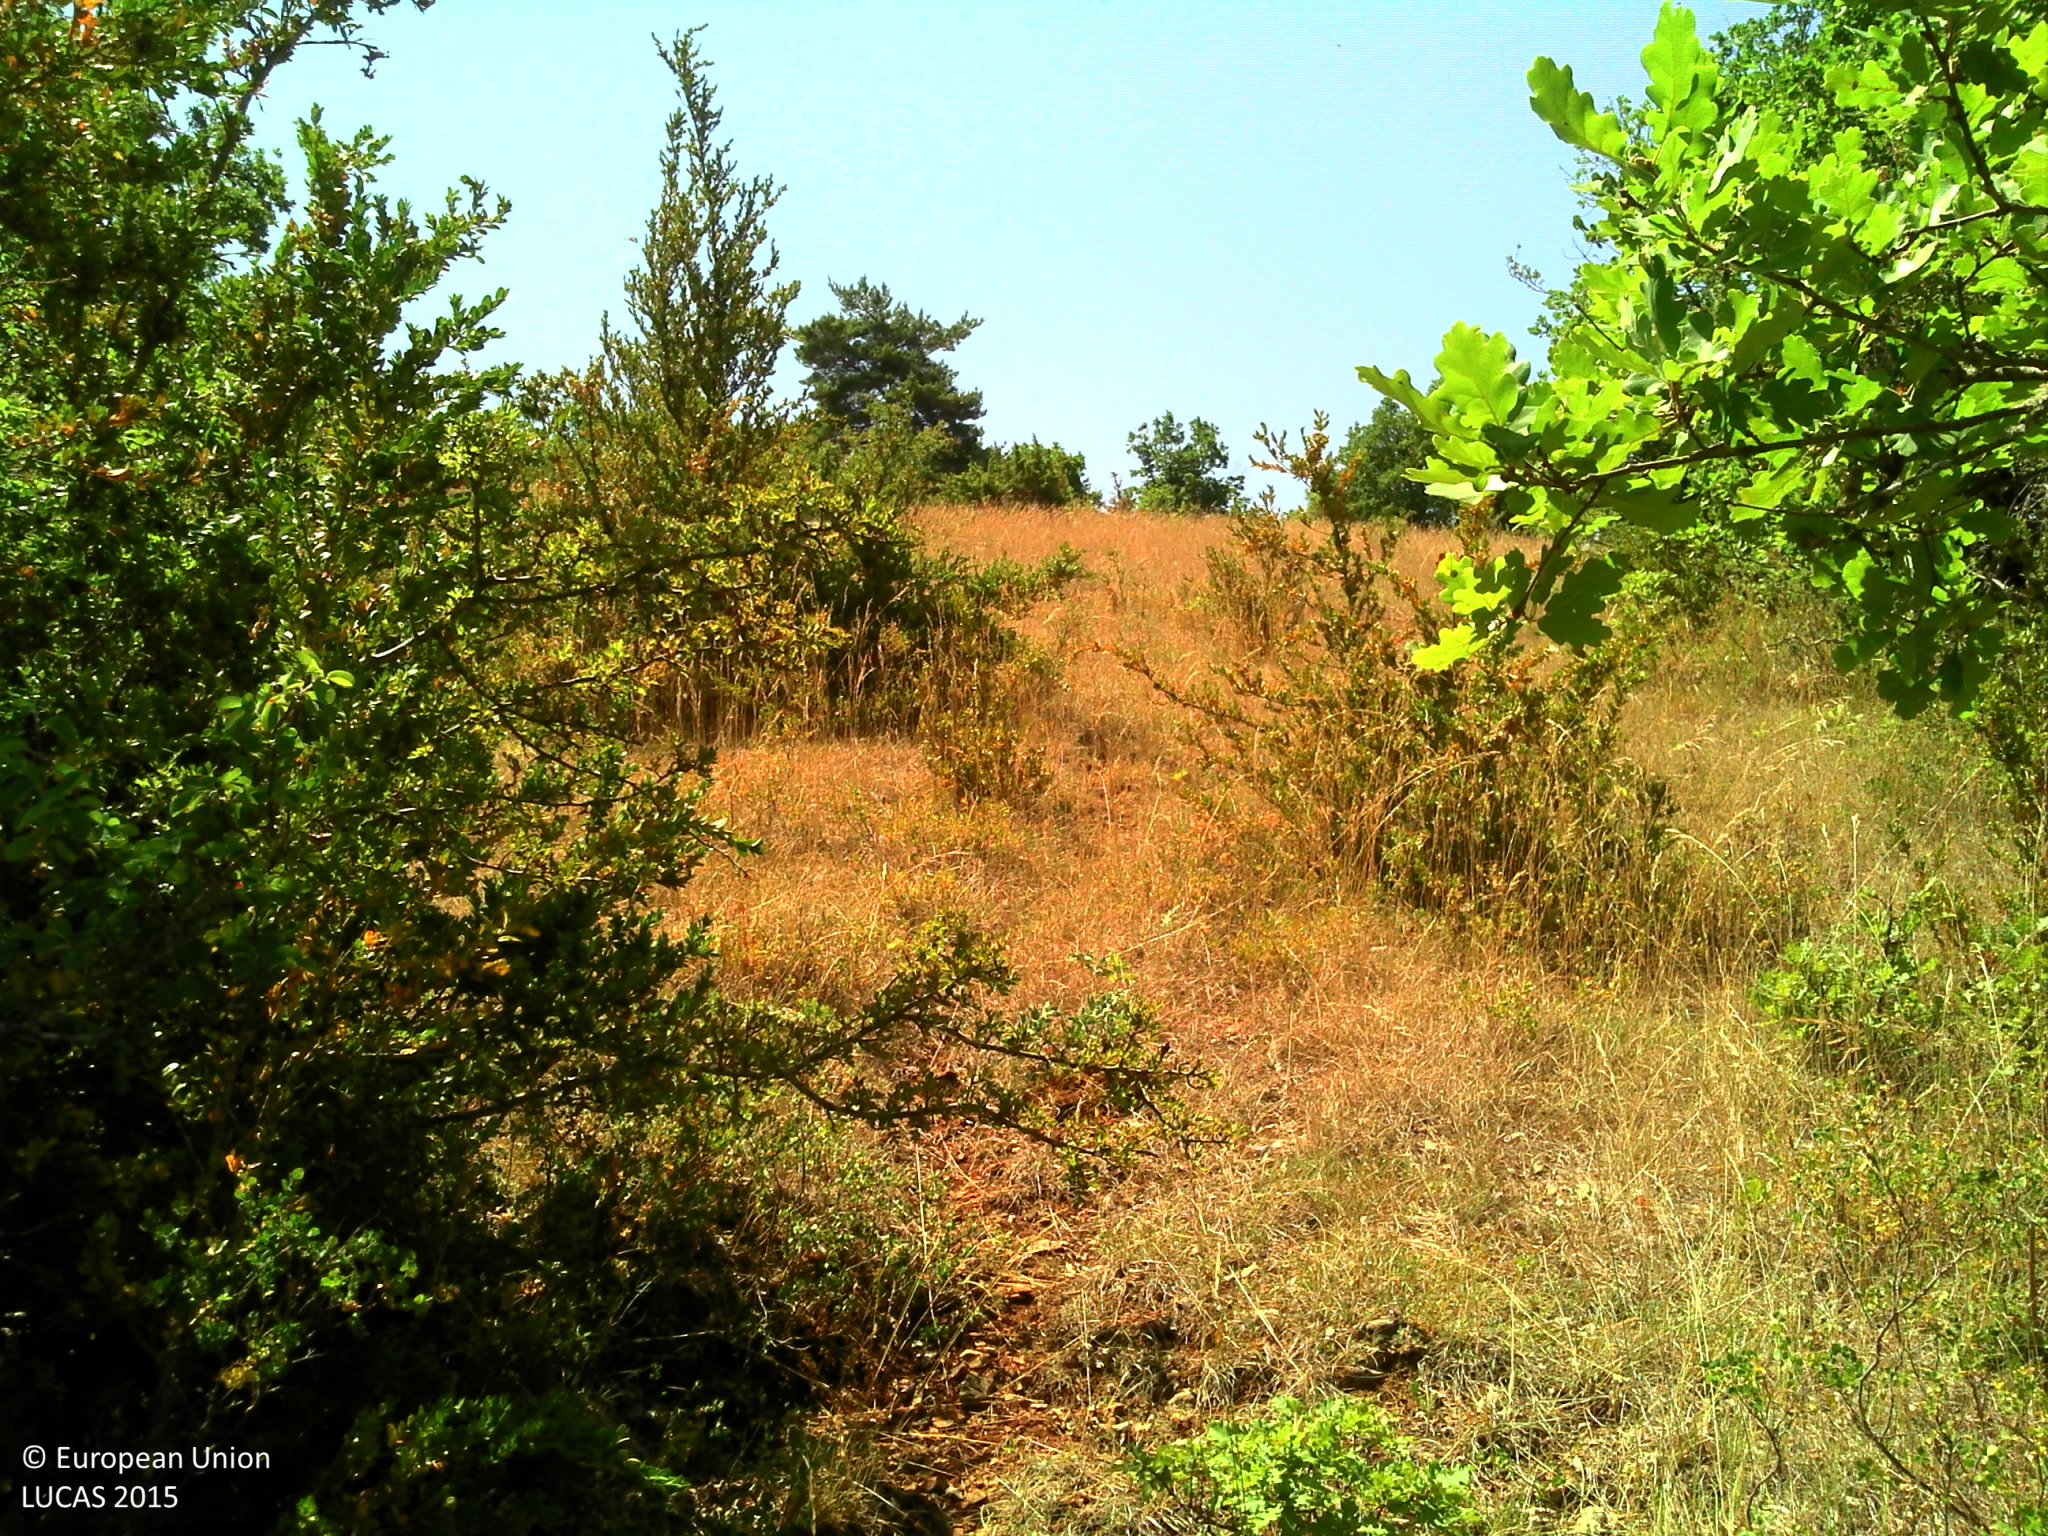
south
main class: Shrubland
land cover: Shrubland with sparse tree cover
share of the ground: > 75 %
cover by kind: shrubs 90 %, broadleaved forest trees 5 %, herbaceous plants 5 %
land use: Semi-natural and natural areas not in use
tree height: > 5 m
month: July
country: FR
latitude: 44.1676
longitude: 2.9894
